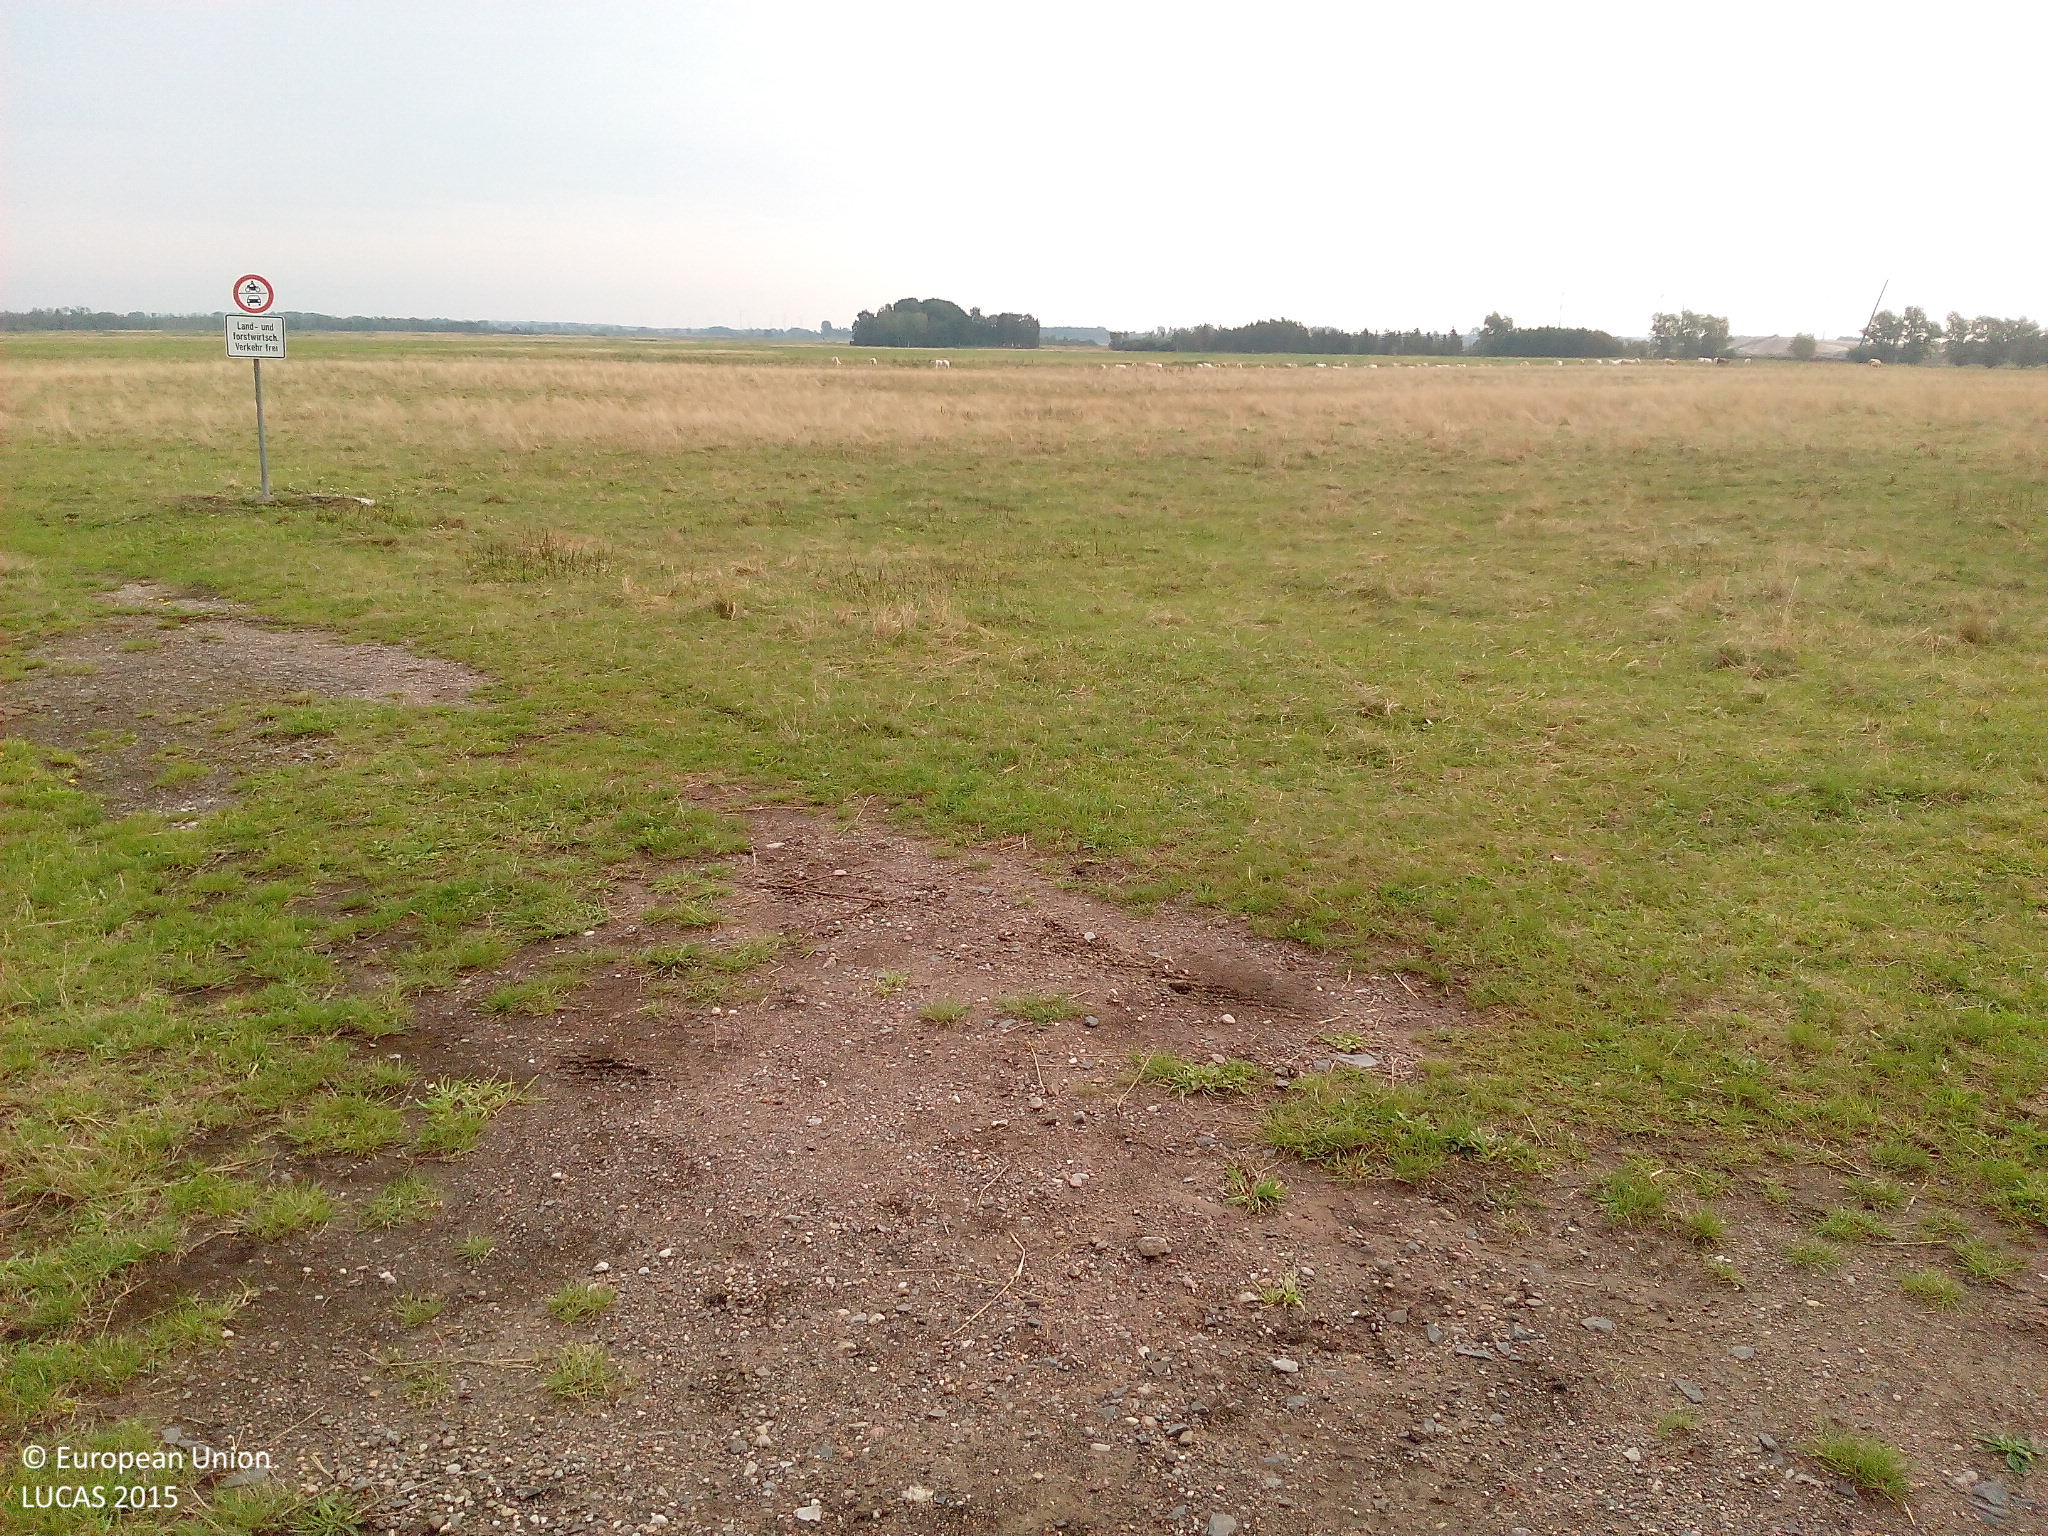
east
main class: Grassland
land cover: Spontaneously vegetated surfaces
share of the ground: > 75 %
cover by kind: herbaceous plants 100 %
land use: Semi-natural and natural areas not in use
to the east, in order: Spontaneously vegetated surfaces; Inland fresh running water; Grassland without tree/shrub cover
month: August
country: DE
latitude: 54.0911
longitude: 12.7052
